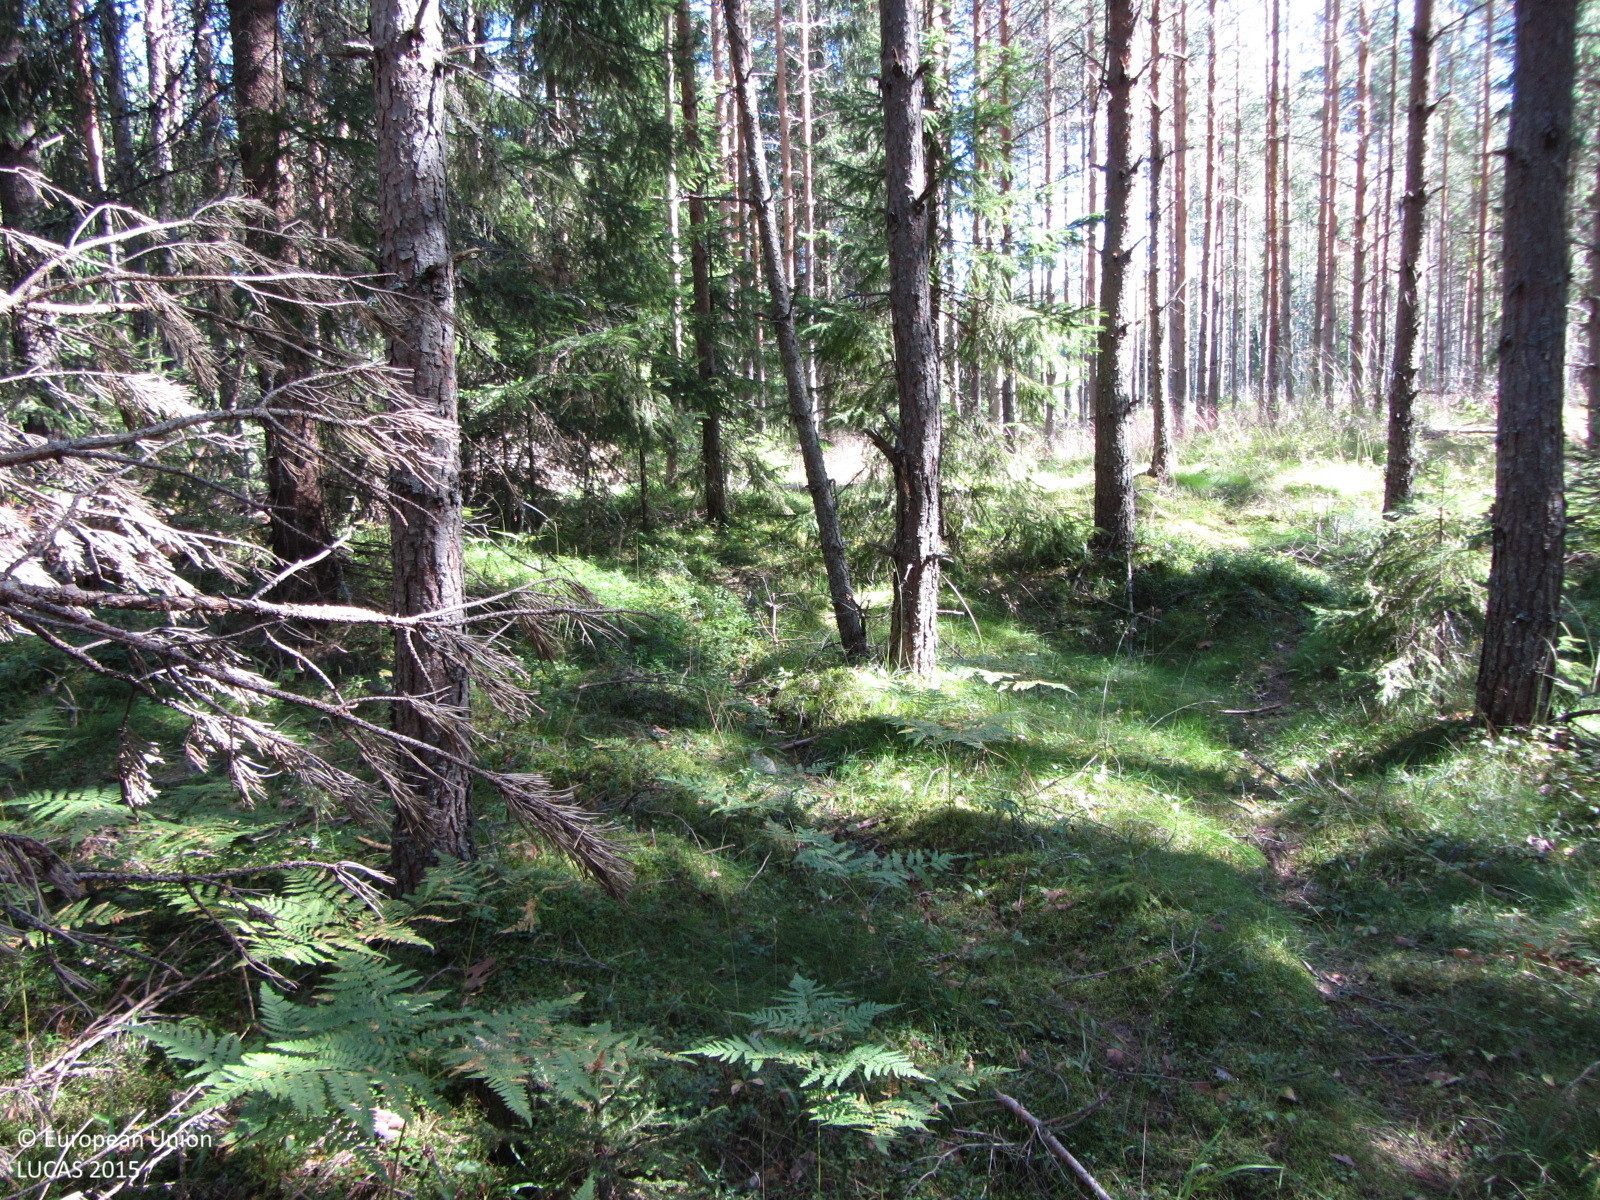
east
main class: Woodland
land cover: Pine dominated mixed woodland
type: boreal forest
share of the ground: > 75 %
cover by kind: coniferous forest trees 60 %, broadleaved forest trees 25 %, herbaceous plants 10 %, lichens and mosses 5 %
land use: Forestry
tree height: > 5 m
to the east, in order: Pine dominated mixed woodland; Other coniferous woodland; Grassland with sparse tree/shrub cover; Spruce dominated mixed woodland; Grassland with sparse tree/shrub cover; Tracks; Broadleaved woodland; Ditches and canals; Broadleaved woodland; Spruce dominated mixed woodland; Broadleaved woodland
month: August
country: FI
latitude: 60.5052
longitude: 23.9889
